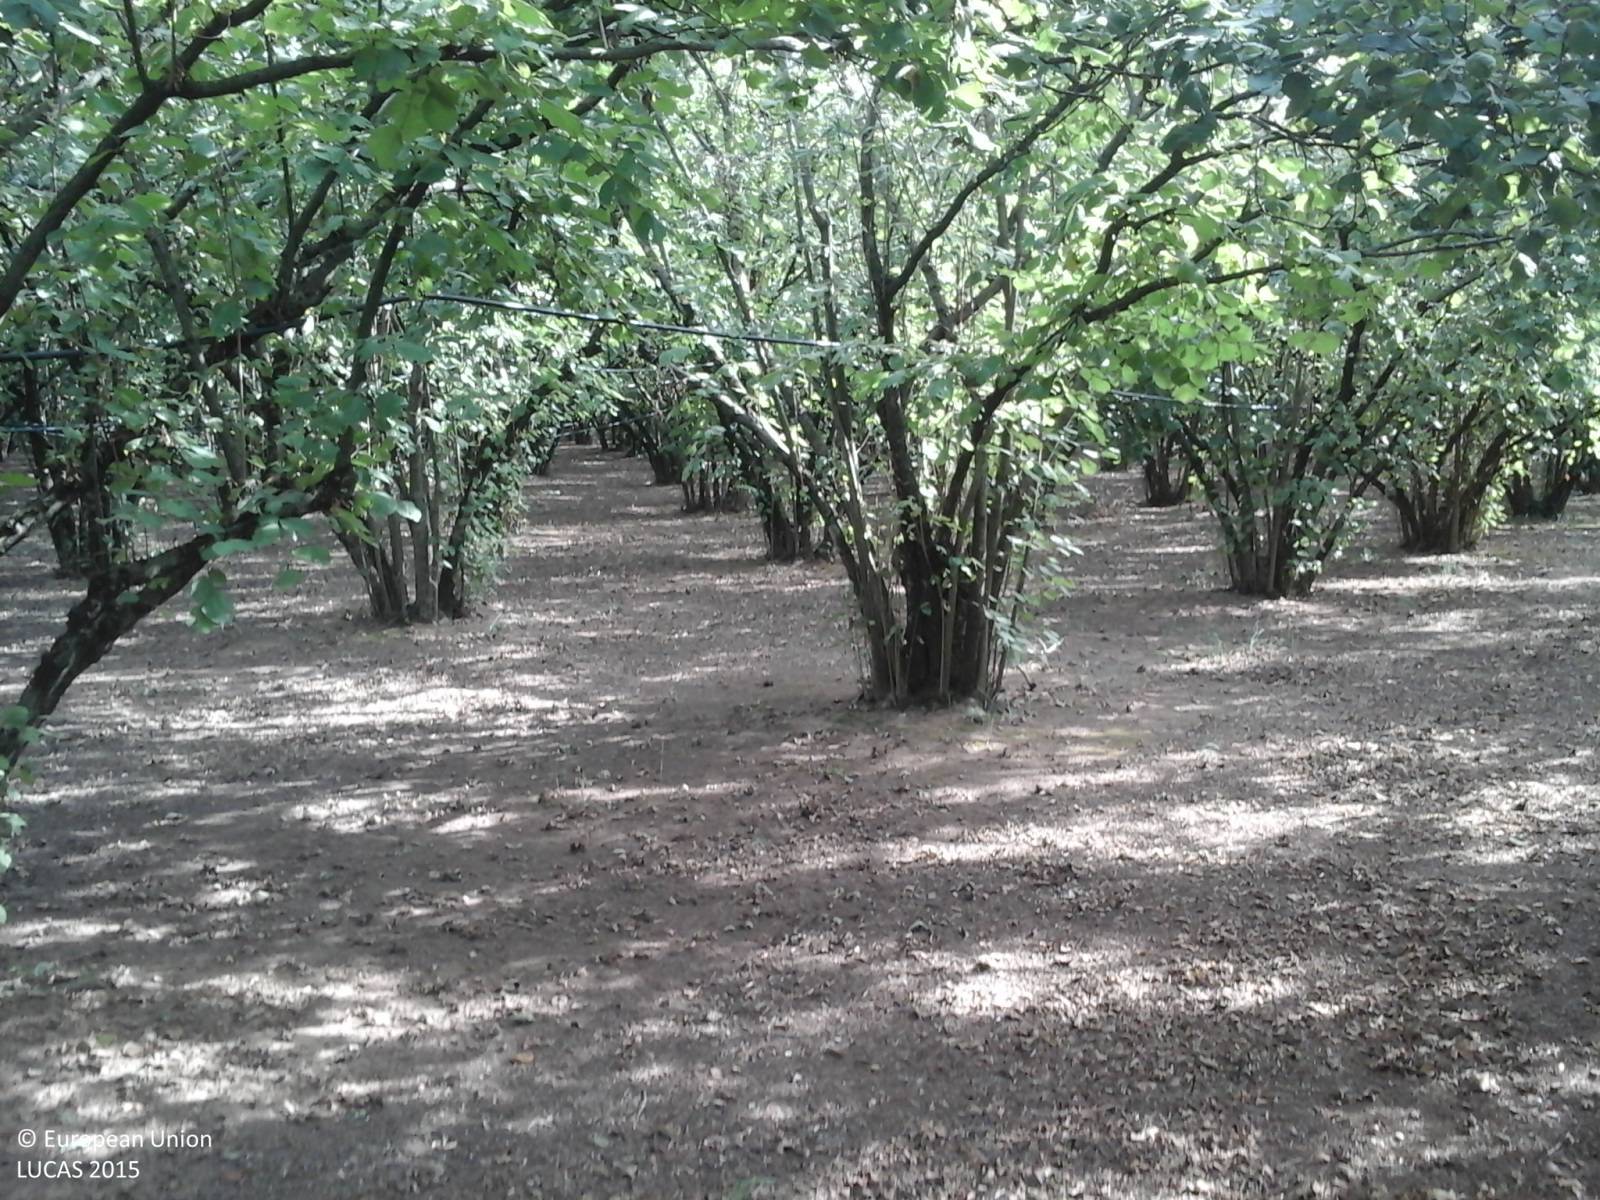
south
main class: Cropland
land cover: Nuts trees
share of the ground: > 75 %
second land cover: Other bare soil
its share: > 75 %
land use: Agriculture (excluding fallow land and kitchen gardens)
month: September
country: IT
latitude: 42.3741
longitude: 12.3359
